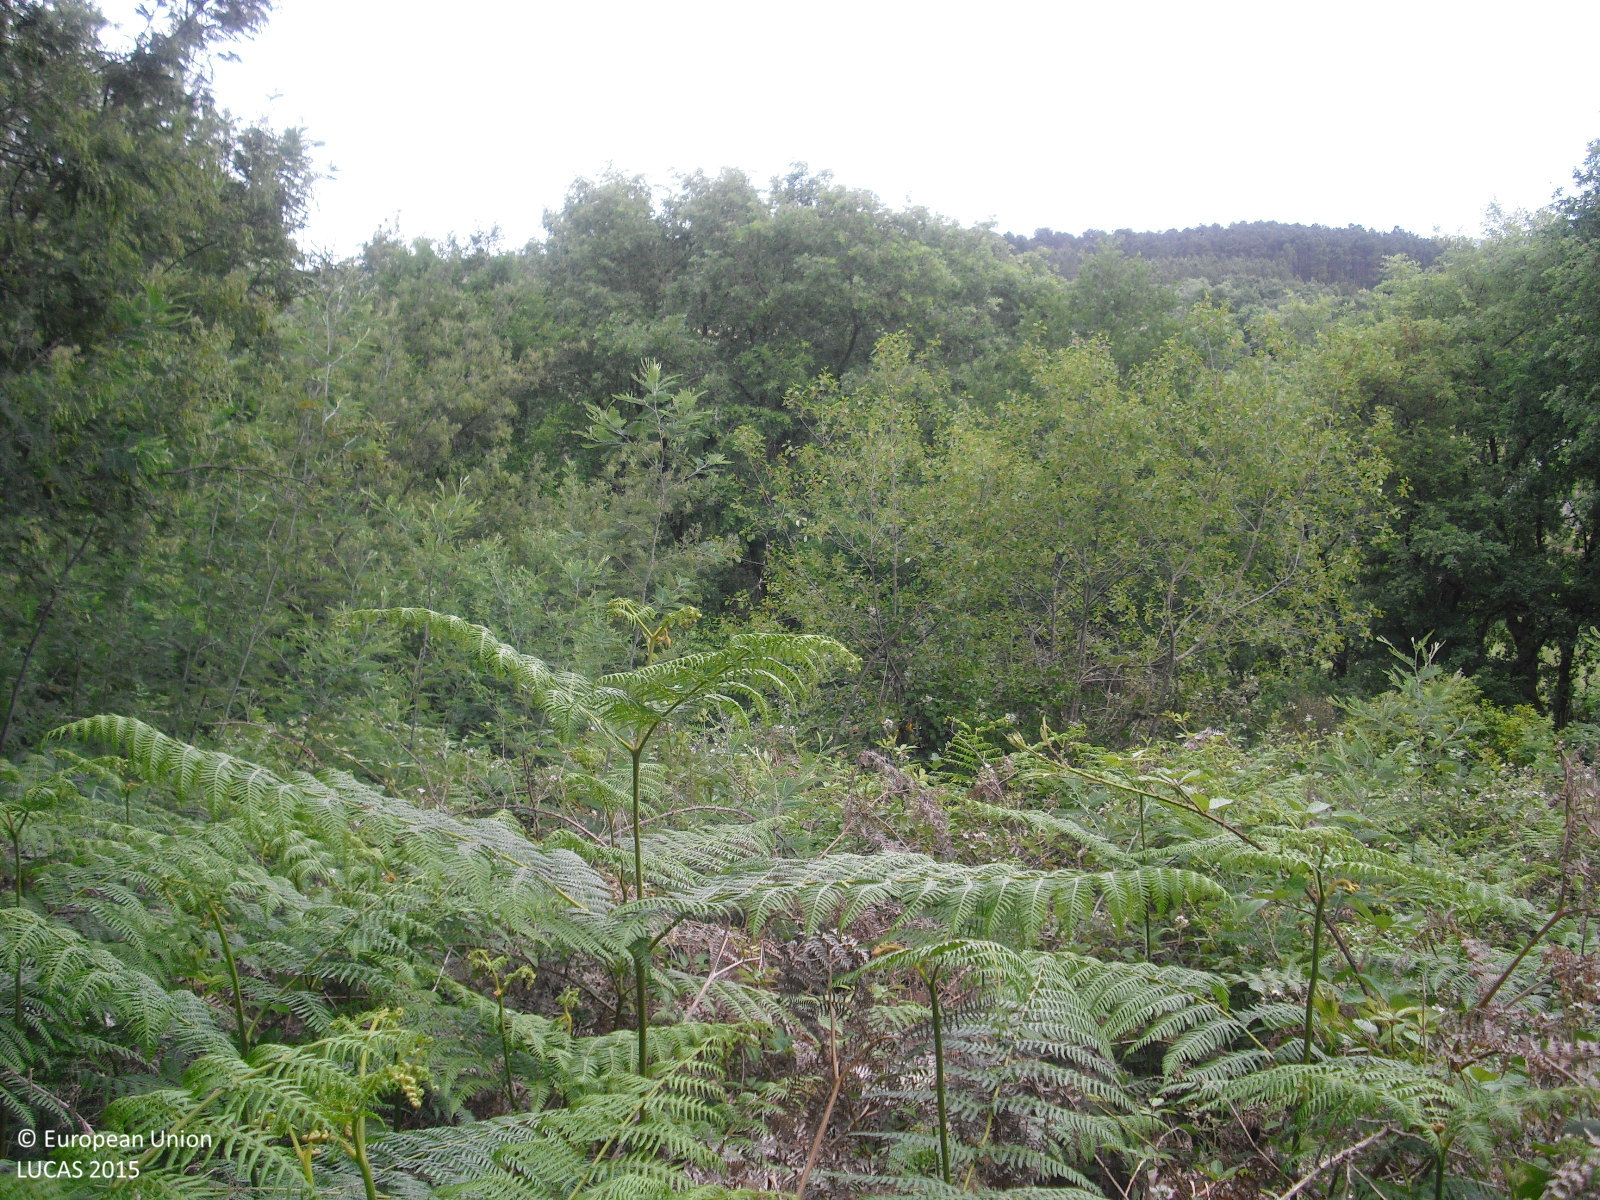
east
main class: Woodland
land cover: Broadleaved woodland
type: acidophilous oak and oak-birch forest
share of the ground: 25 - 50 %
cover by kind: shrubs 60 %, broadleaved forest trees 40 %
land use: Forestry
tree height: > 5 m
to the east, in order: Broadleaved woodland; Shrubland without tree cover; Broadleaved woodland; Ditches and canals; Shruby margins; Paved roads, cycling and walking lanes; Spontaneously vegetated surfaces; Ditches and canals; Grass margins; Paved roads, cycling and walking lanes; Electric lines; Shruby margins; Fences; Shruby margins; Tracks; Grassland with sparse tree/shrub cover; Electric lines; Grassland with sparse tree/shrub cover; Artificial constructions in urban areas; Grassland without tree/shrub cover; Broadleaved woodland; Shrubland without tree cover; Rivers and streams; Broadleaved woodland; Shrubland without tree cover; Tracks; Ditches and canals; Grass margins; Tracks; Broadleaved woodland
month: May
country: ES
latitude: 42.1992
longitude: -7.9406
